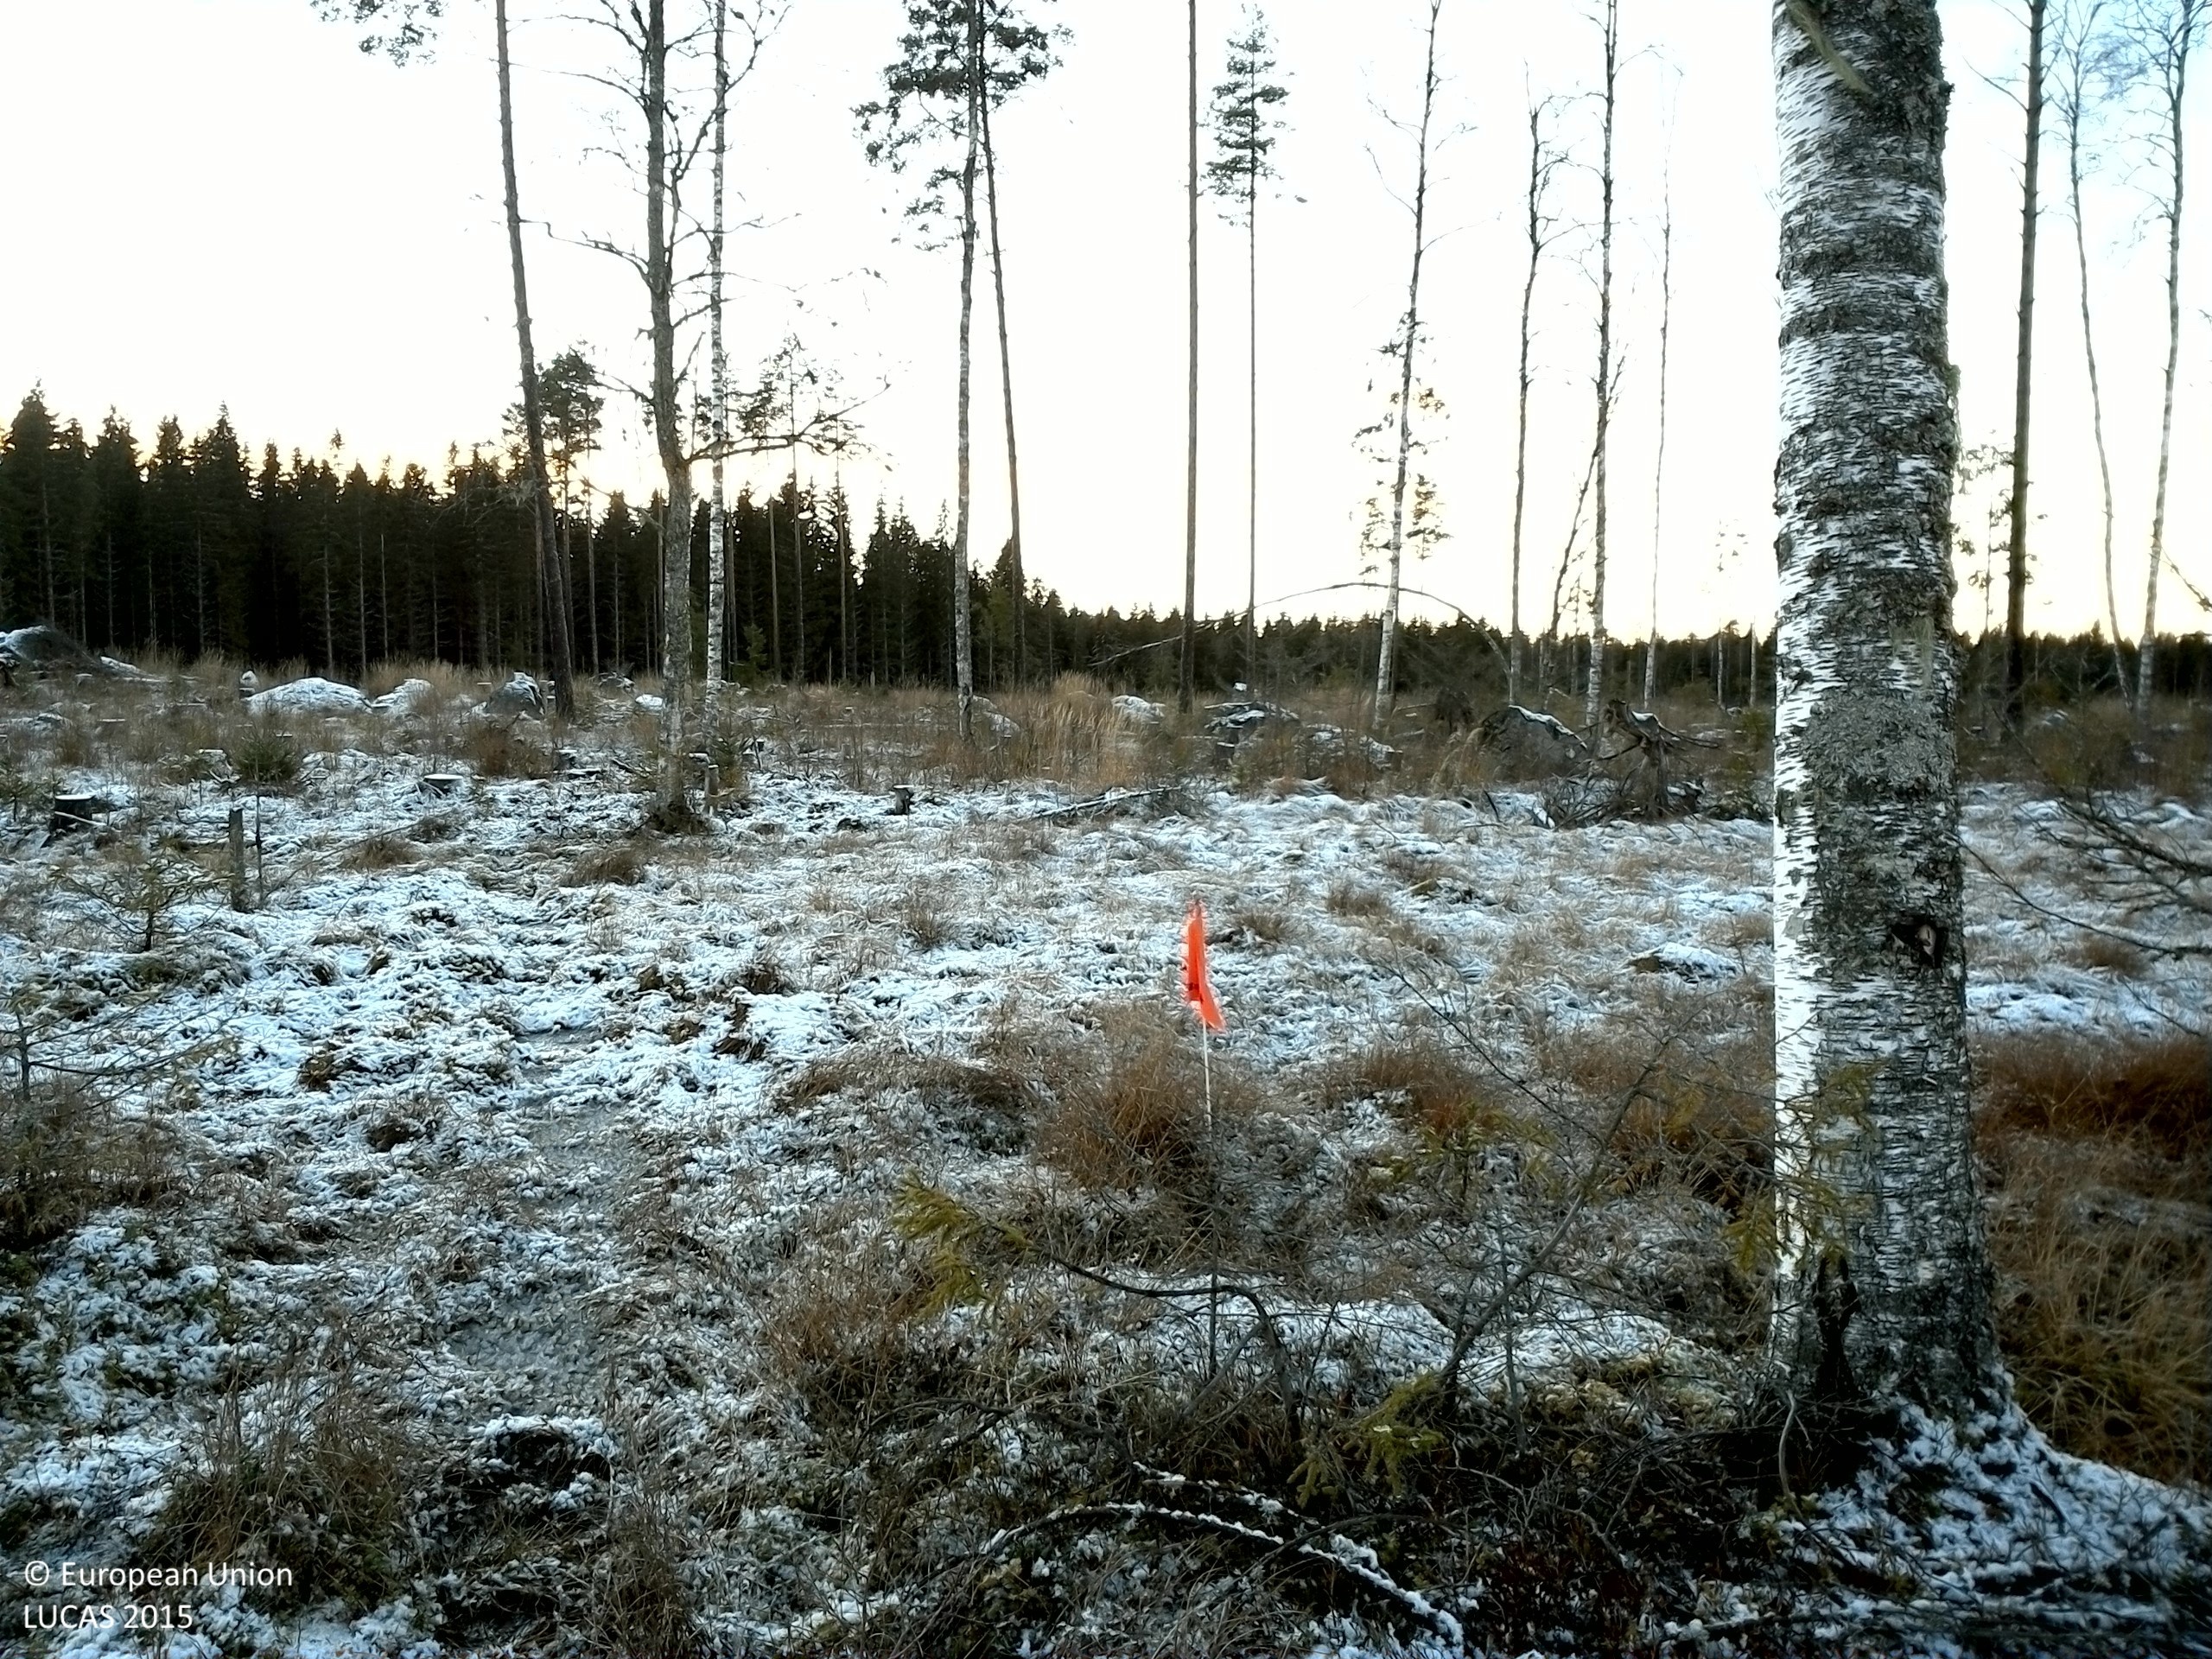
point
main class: Grassland
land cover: Grassland with sparse tree/shrub cover
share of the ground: 50 - 75 %
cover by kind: herbaceous plants 55 %, lichens and mosses 20 %, shrubs 10 %, consolidated bare surface 10 %, broadleaved forest trees 5 %
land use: Forestry
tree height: > 5 m
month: November
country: SE
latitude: 59.7652
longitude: 16.3830
